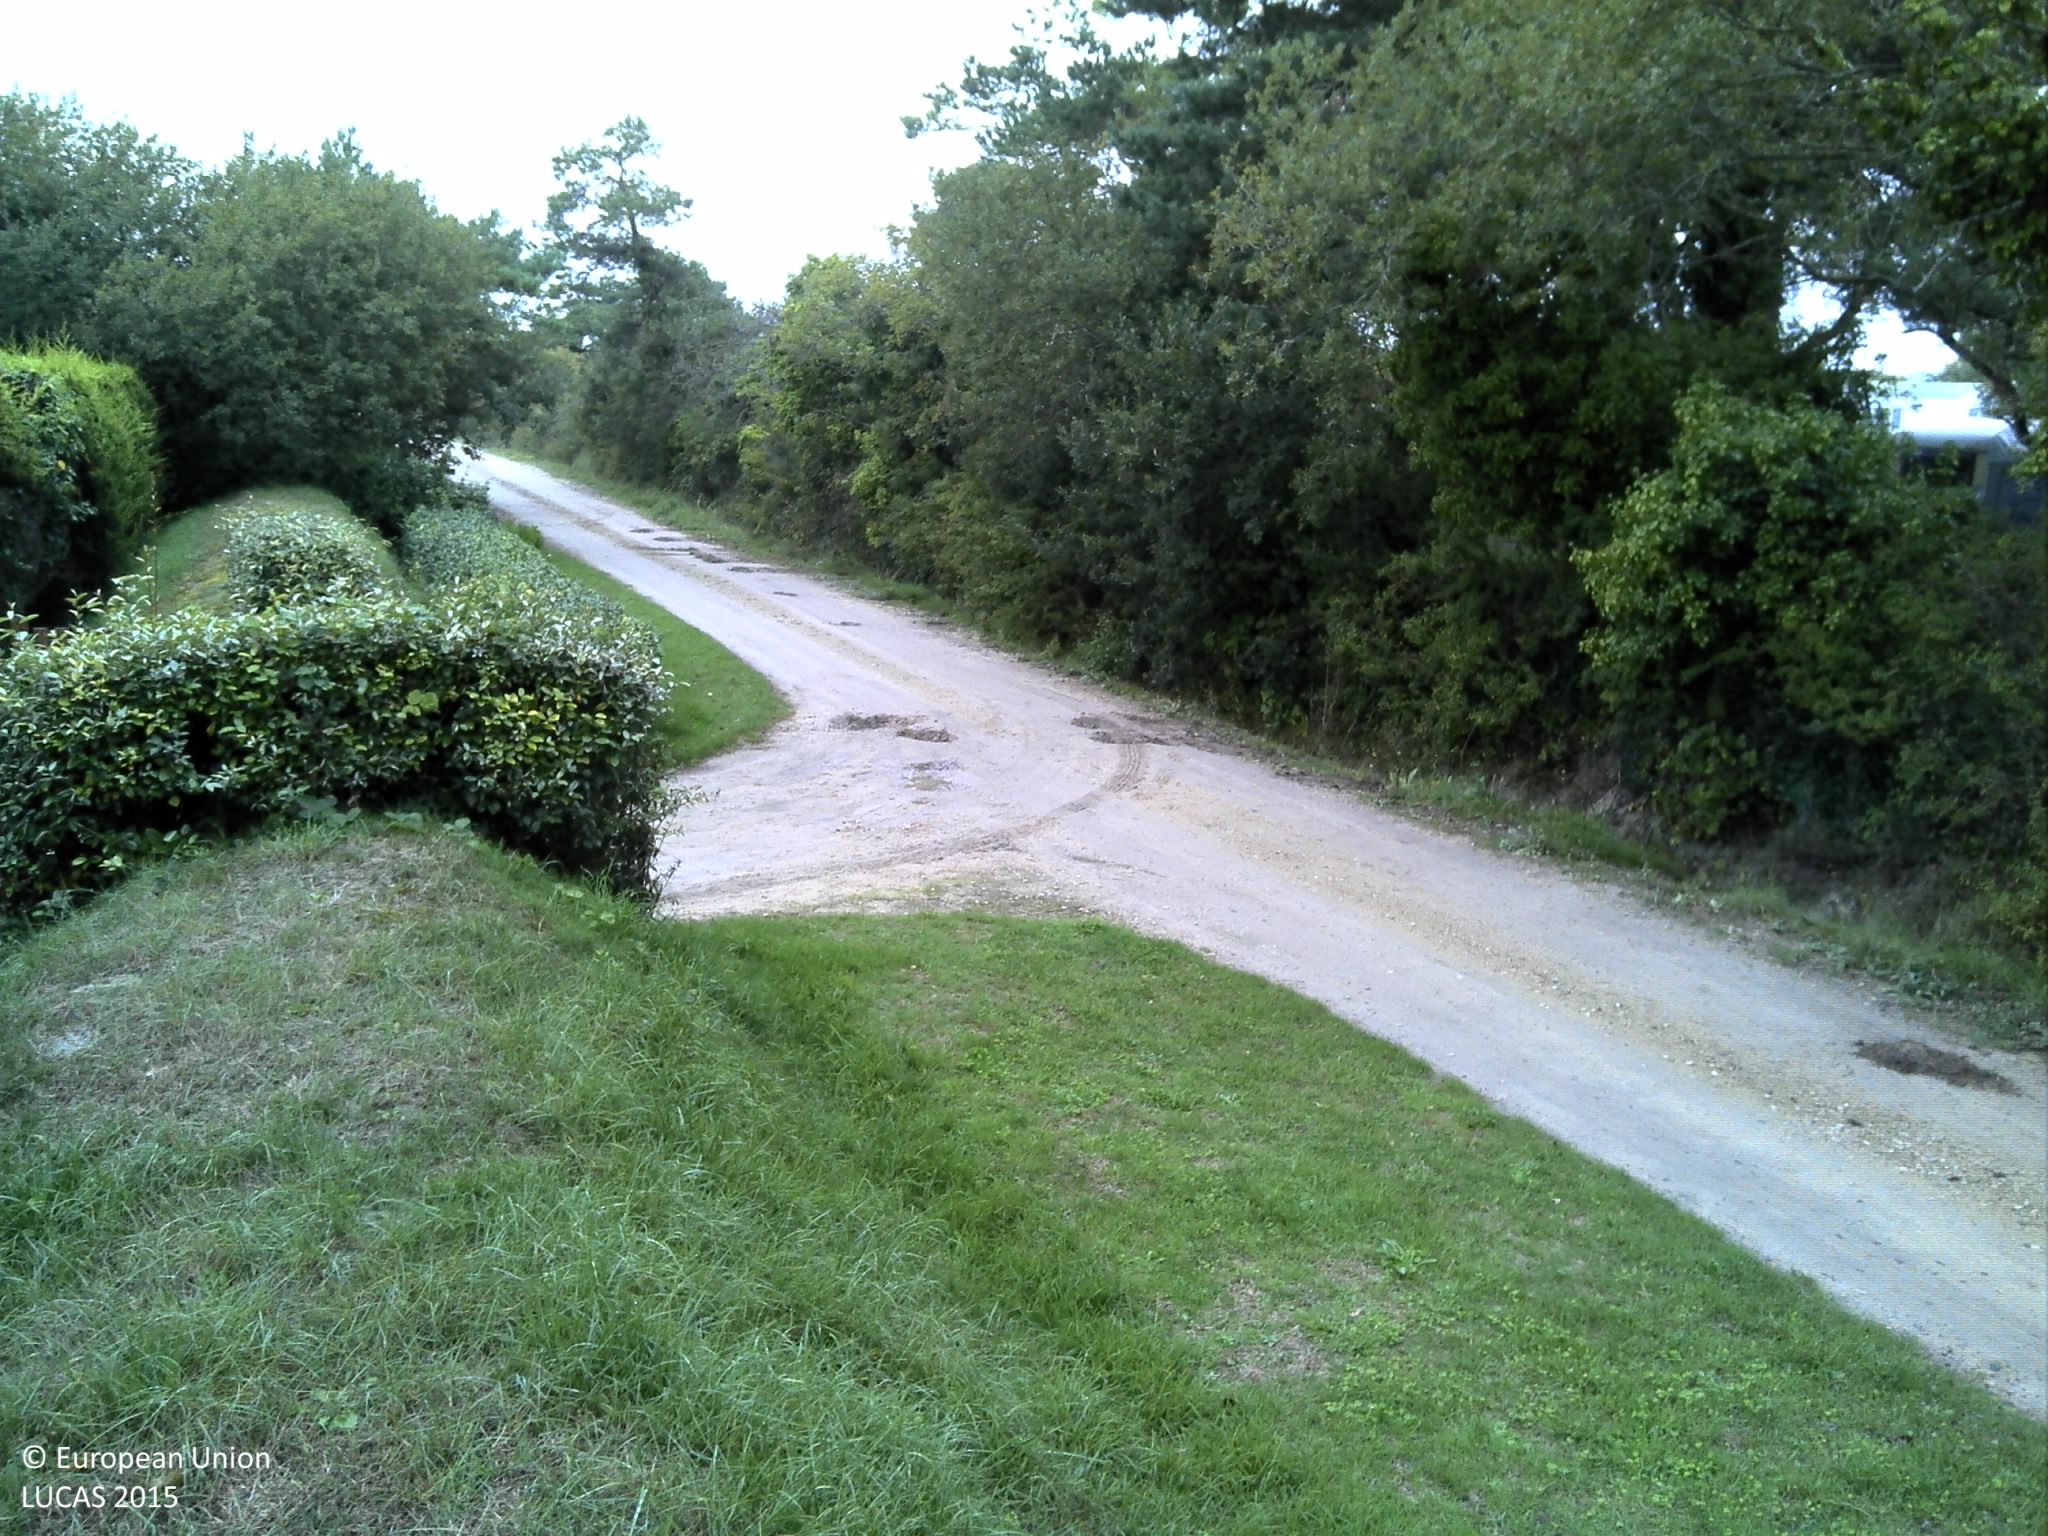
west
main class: Grassland
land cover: Grassland with sparse tree/shrub cover
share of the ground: > 75 %
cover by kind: herbaceous plants 95 %, broadleaved forest trees 5 %
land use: Residential
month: August
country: FR
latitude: 48.6403
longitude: -4.2768
